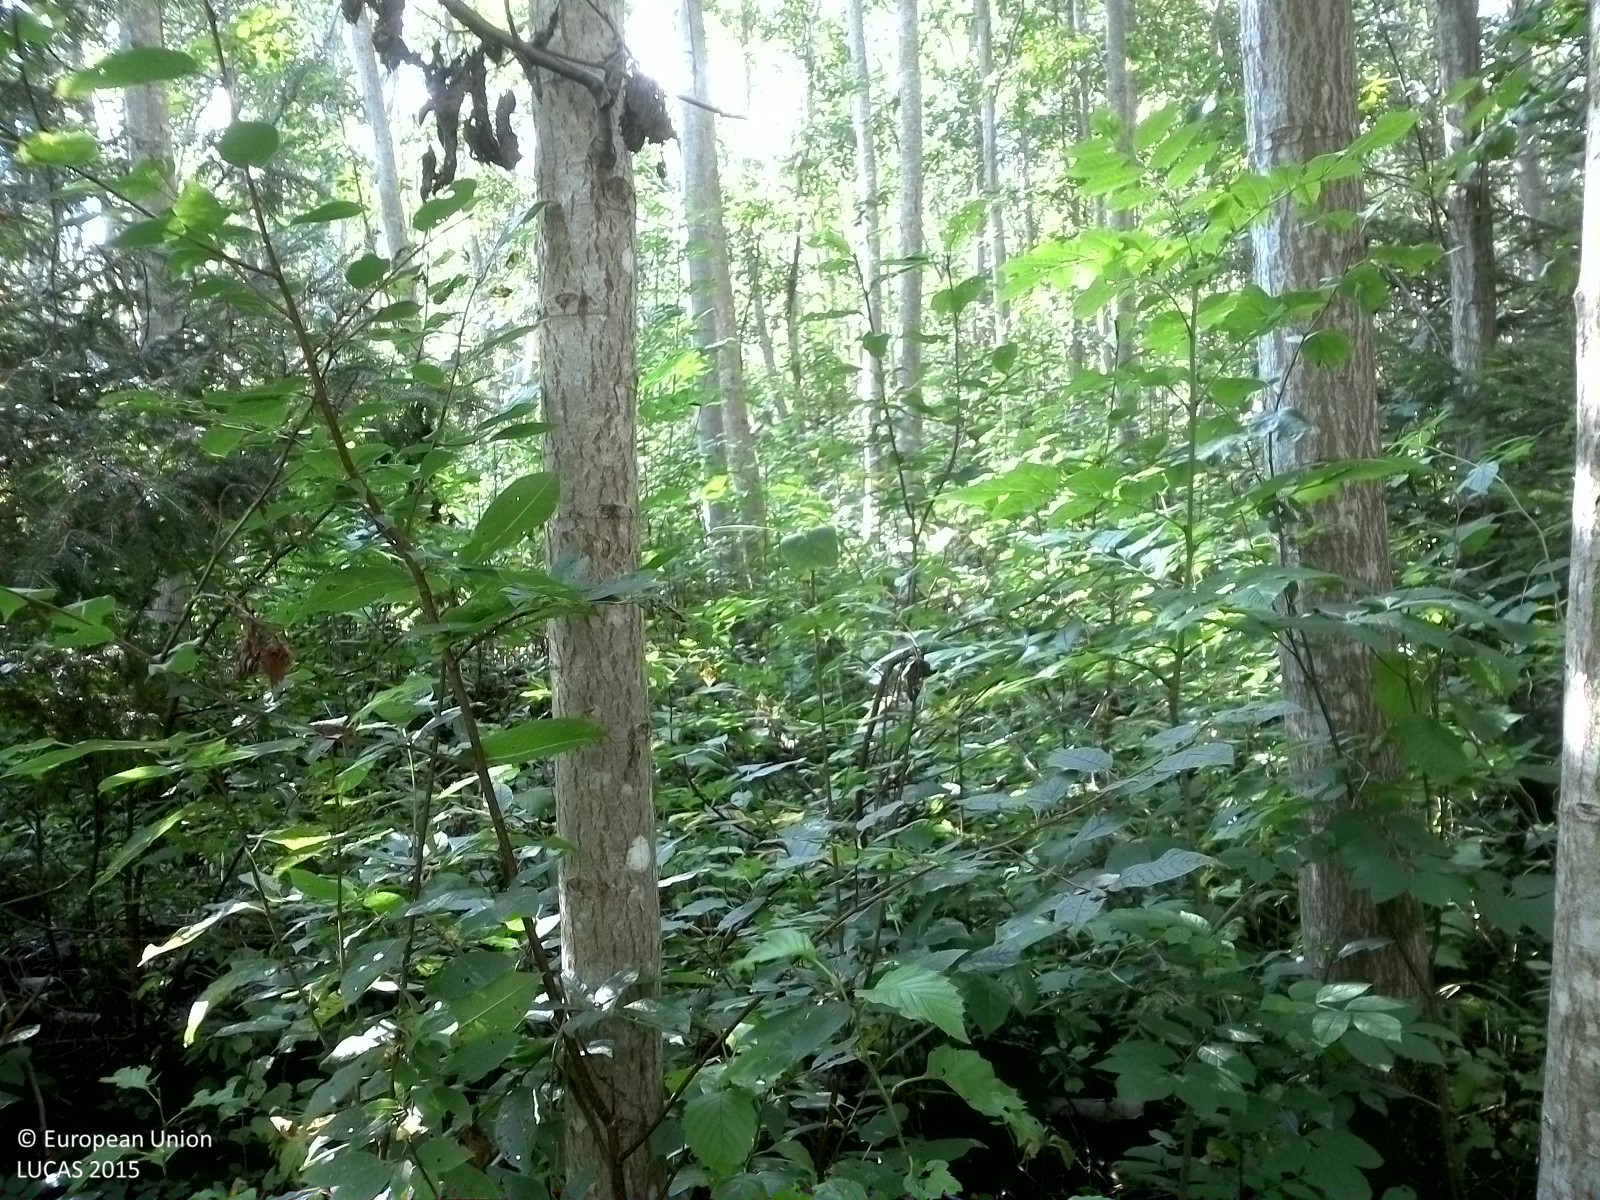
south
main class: Woodland
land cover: Broadleaved woodland
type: hemiboreal forest and nemoral coniferous forest and mixed broadleaved-coniferous forest
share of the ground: 50 - 75 %
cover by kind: broadleaved forest trees 65 %, shrubs 10 %, herbaceous plants 10 %, coniferous forest trees 5 %, lichens and mosses 5 %, unconsolidated bare surface 5 %
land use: Forestry
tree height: > 5 m
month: August
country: SE
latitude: 59.1324
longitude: 15.5667
